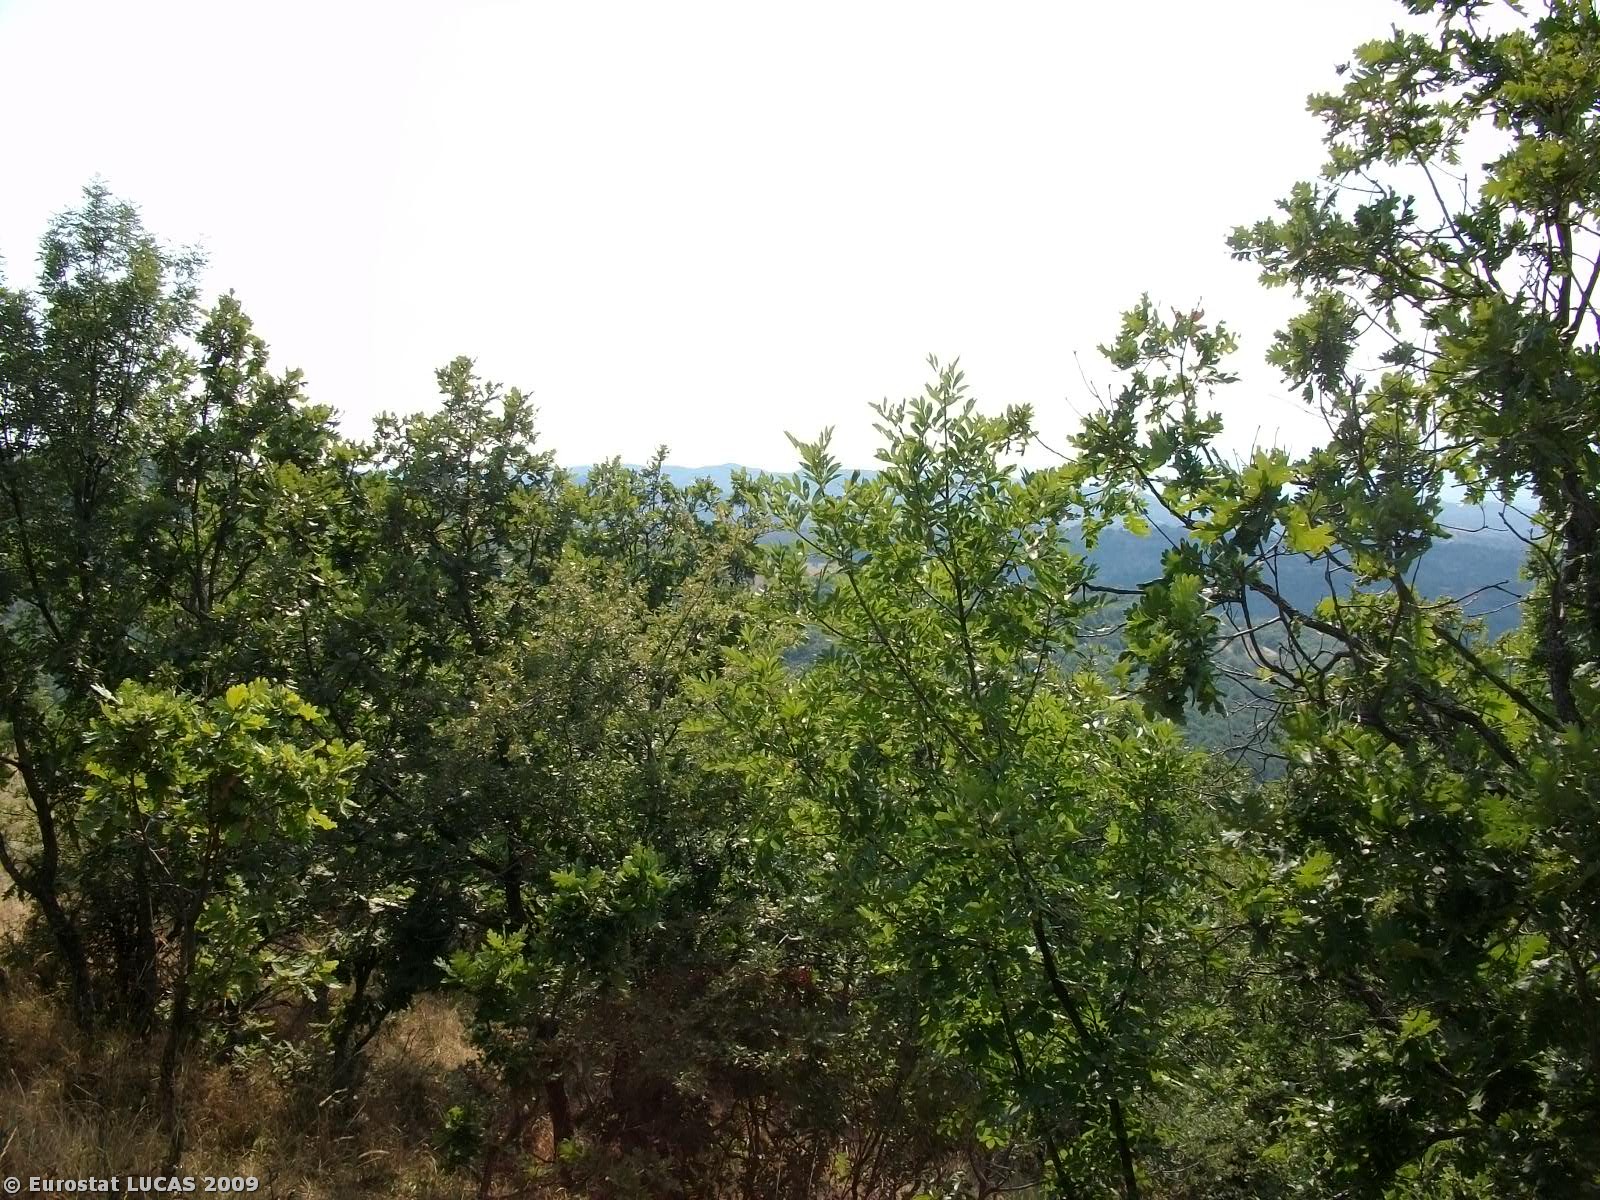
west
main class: Woodland
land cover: Broadleaved woodland
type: thermophilous deciduous forest
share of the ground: 50 - 75 %
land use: Forestry
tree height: > 5 m
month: July
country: GR
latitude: 39.7993
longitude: 21.7233
